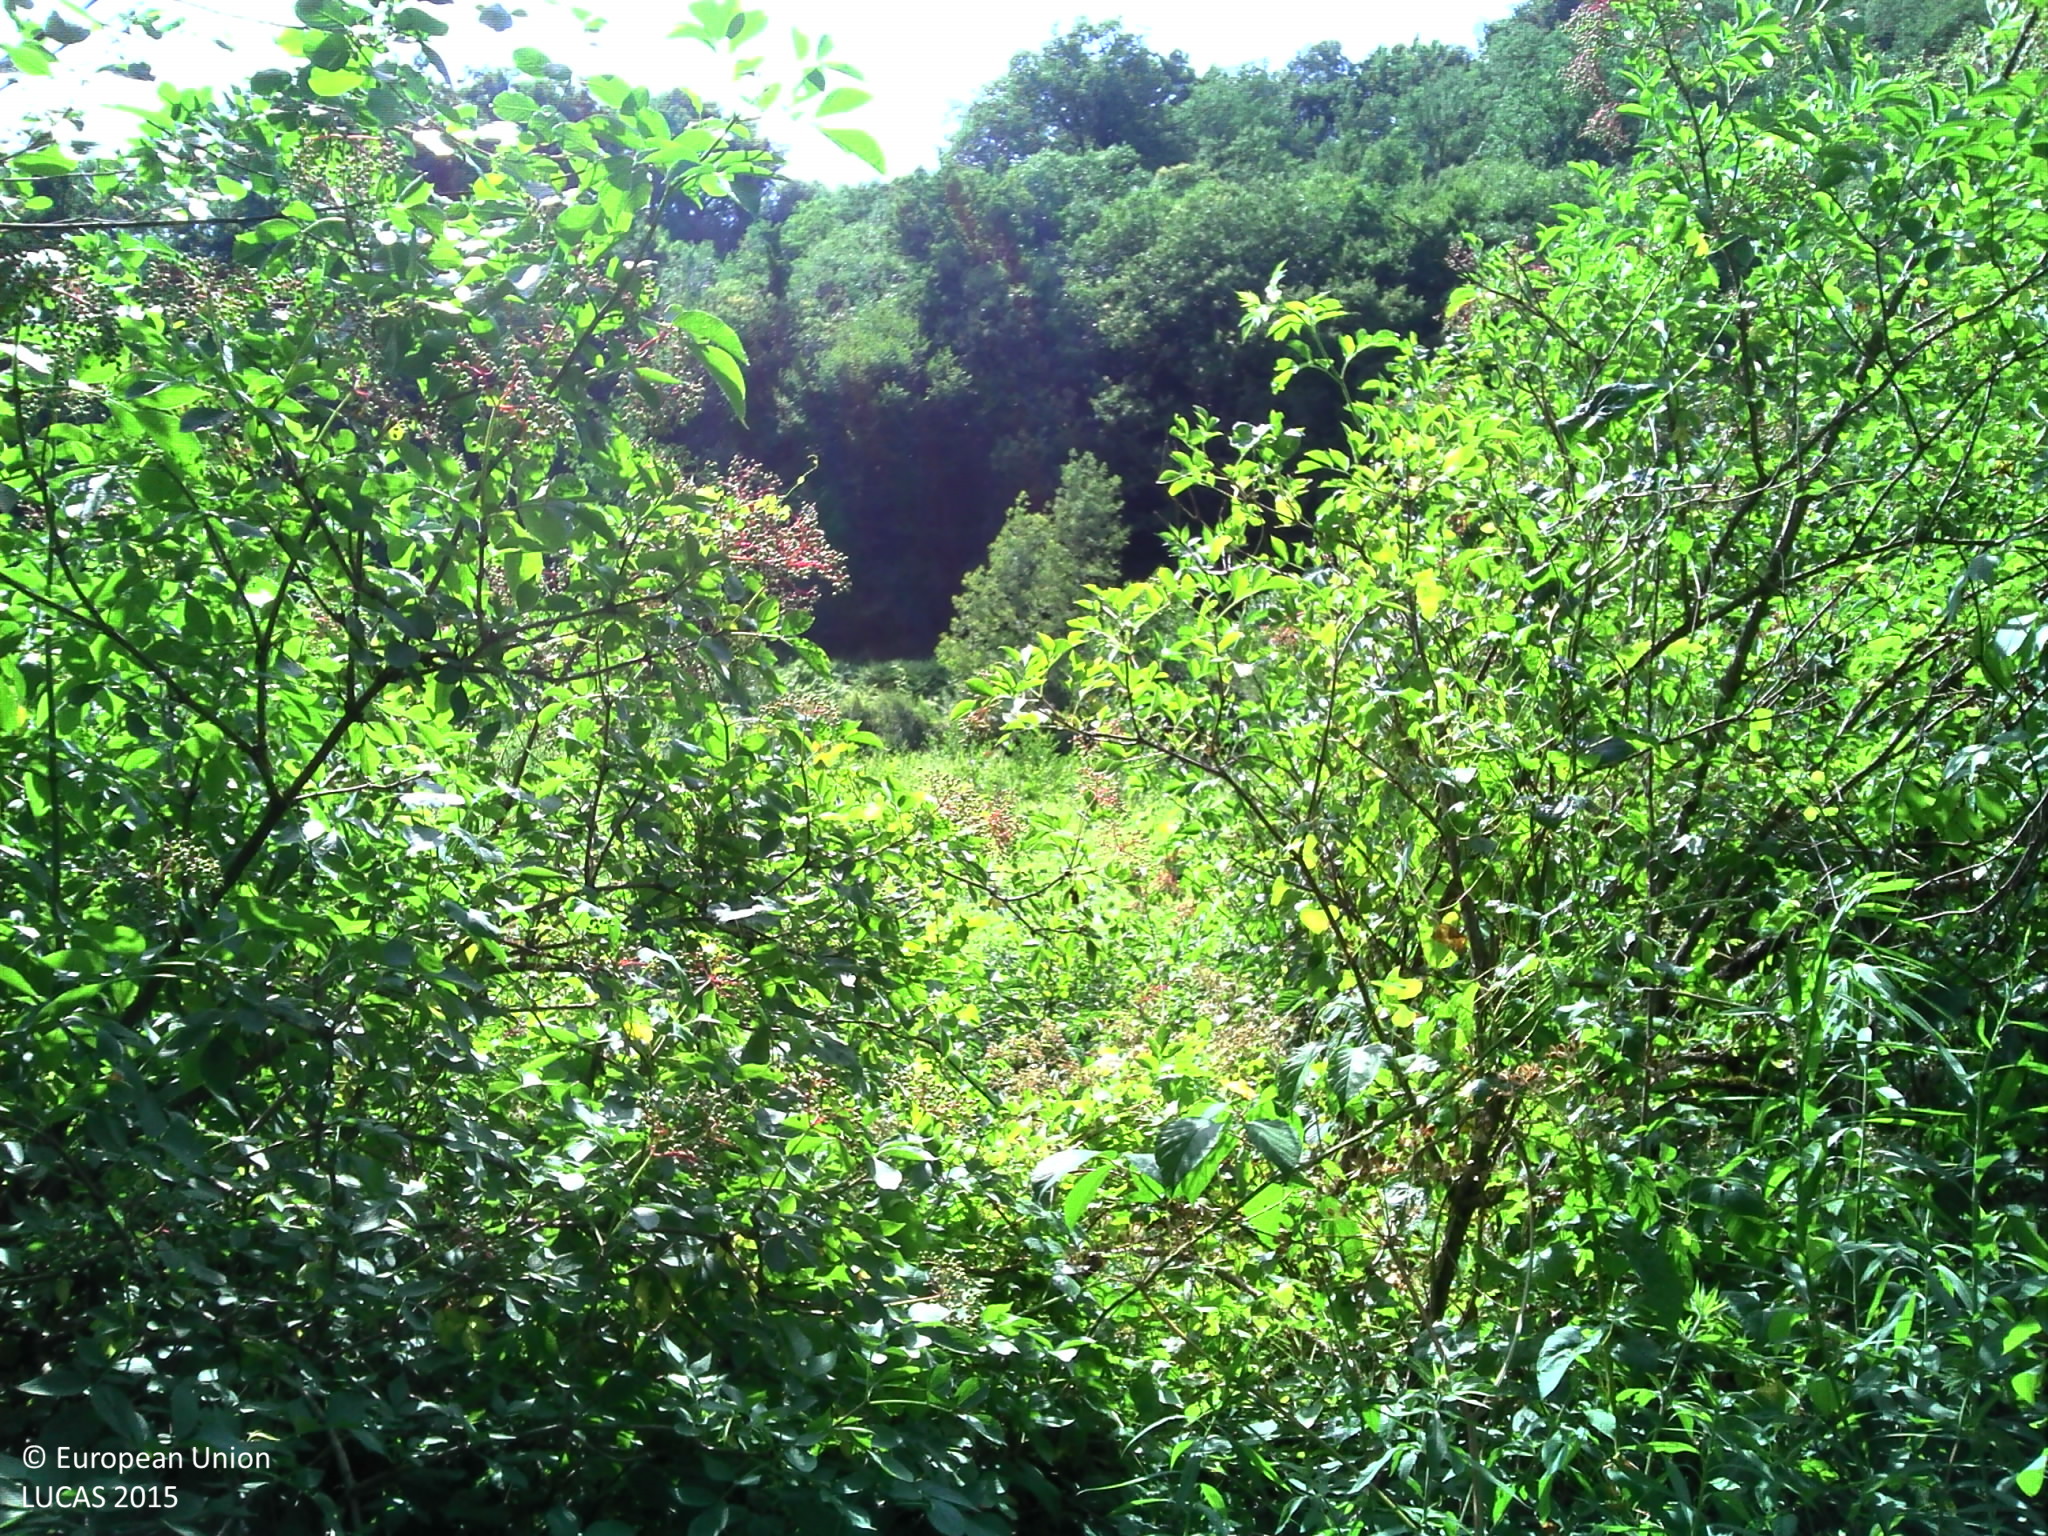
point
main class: Grassland
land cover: Grassland with sparse tree/shrub cover
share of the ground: > 75 %
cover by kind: herbaceous plants 85 %, shrubs 10 %, broadleaved forest trees 5 %
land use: Semi-natural and natural areas not in use
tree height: > 5 m
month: July
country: FR
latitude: 45.5925
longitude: 5.1716
